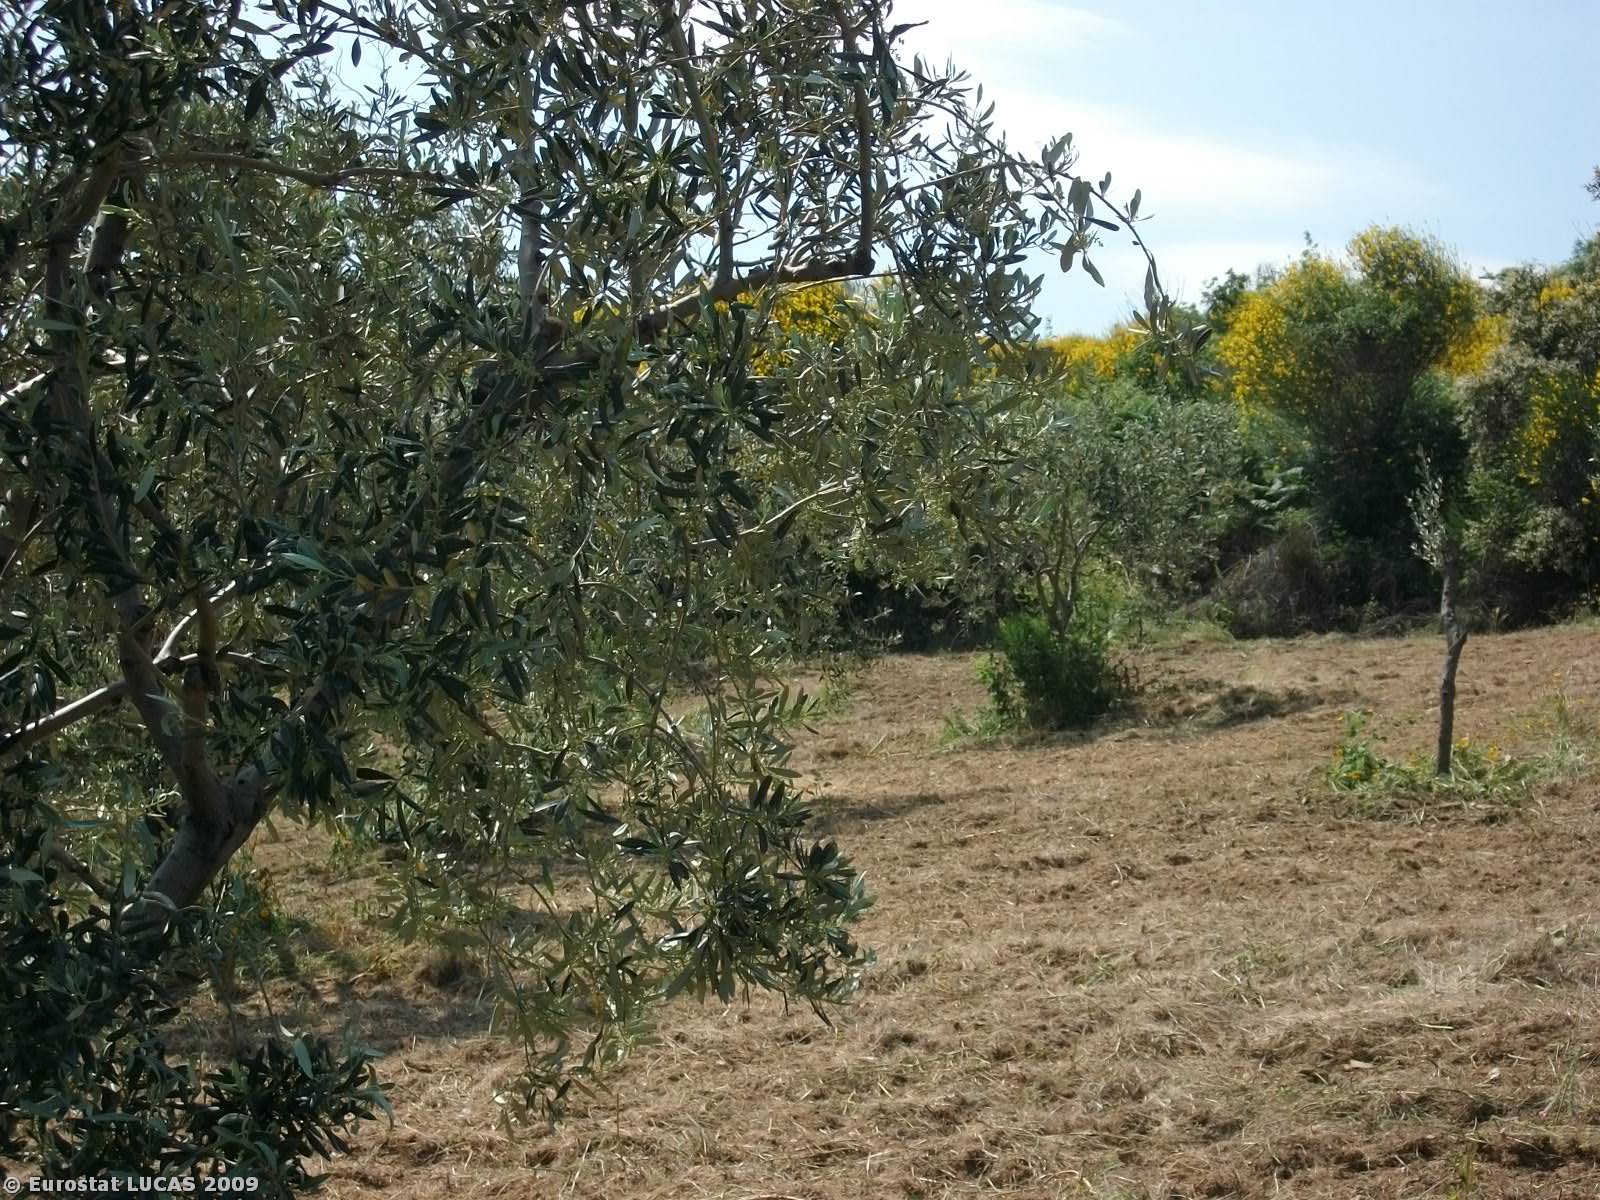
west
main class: Woodland
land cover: Broadleaved woodland
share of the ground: > 75 %
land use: Forestry
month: May
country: GR
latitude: 39.7516
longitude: 22.8217
